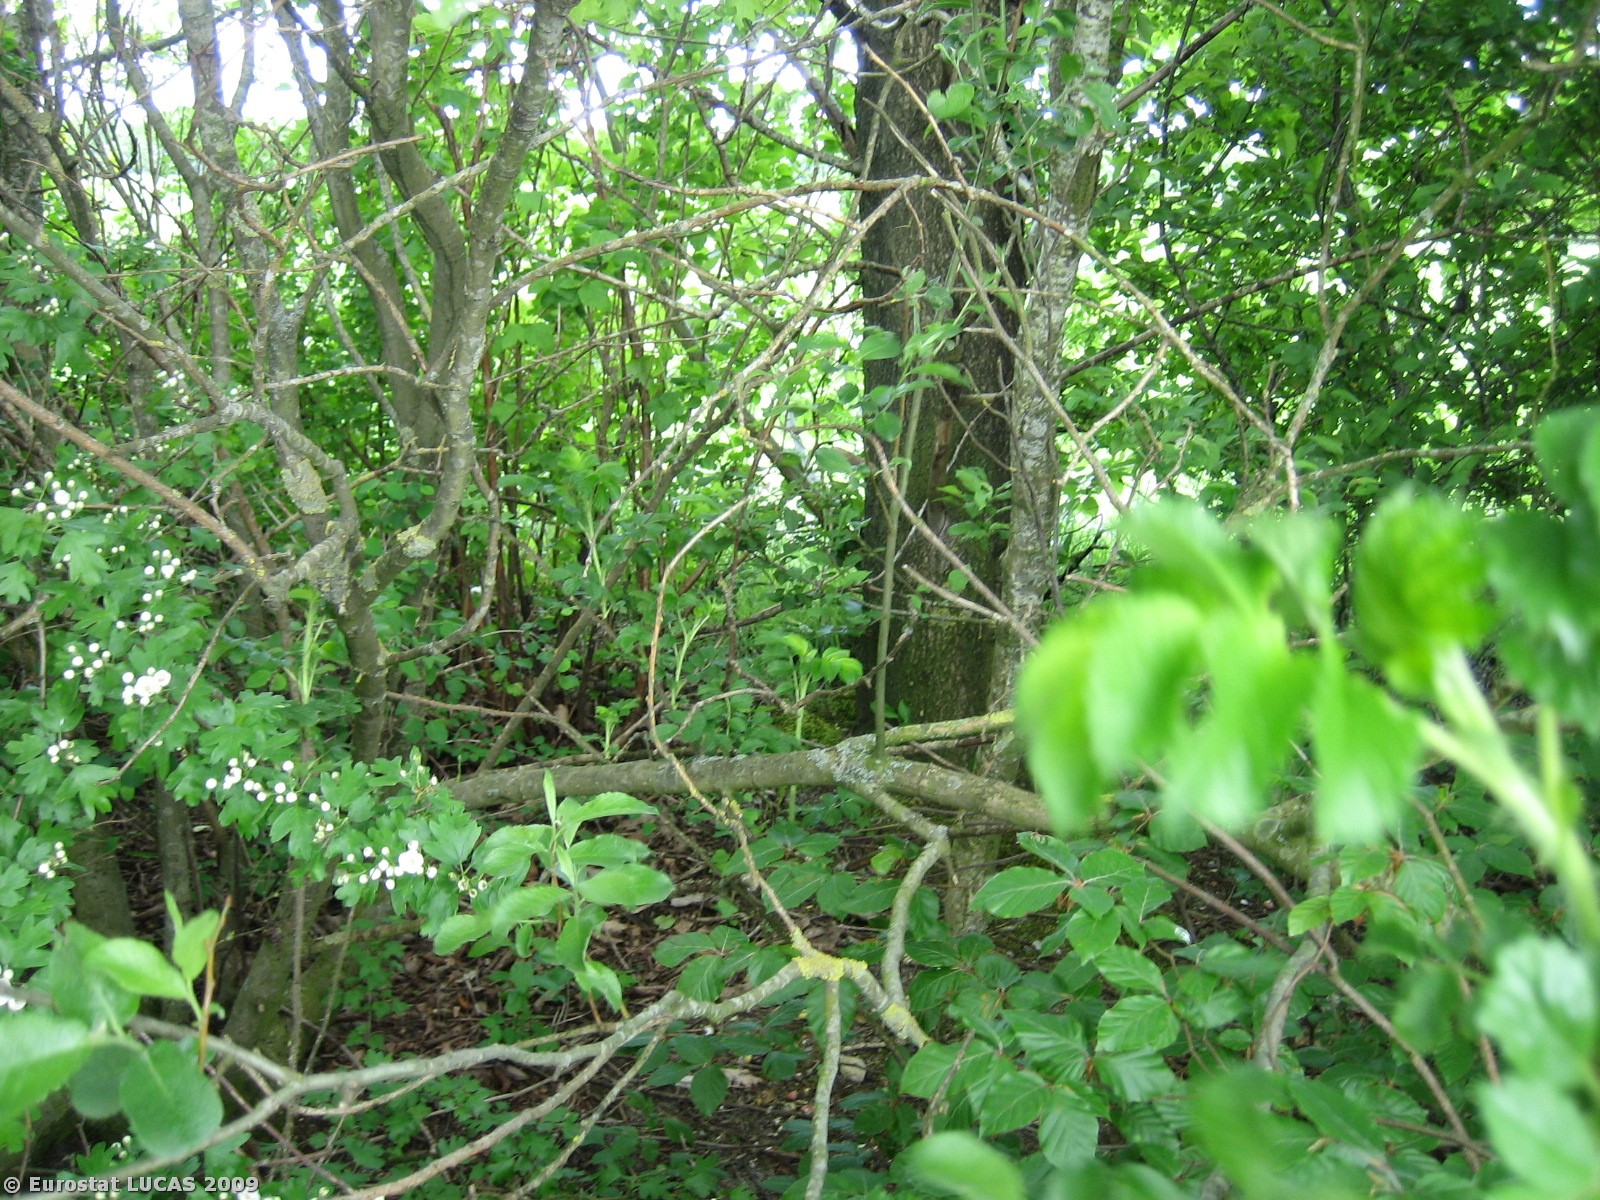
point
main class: Woodland
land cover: Broadleaved woodland
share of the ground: > 75 %
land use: Unused
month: May
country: DK
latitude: 56.2911
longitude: 8.9188
